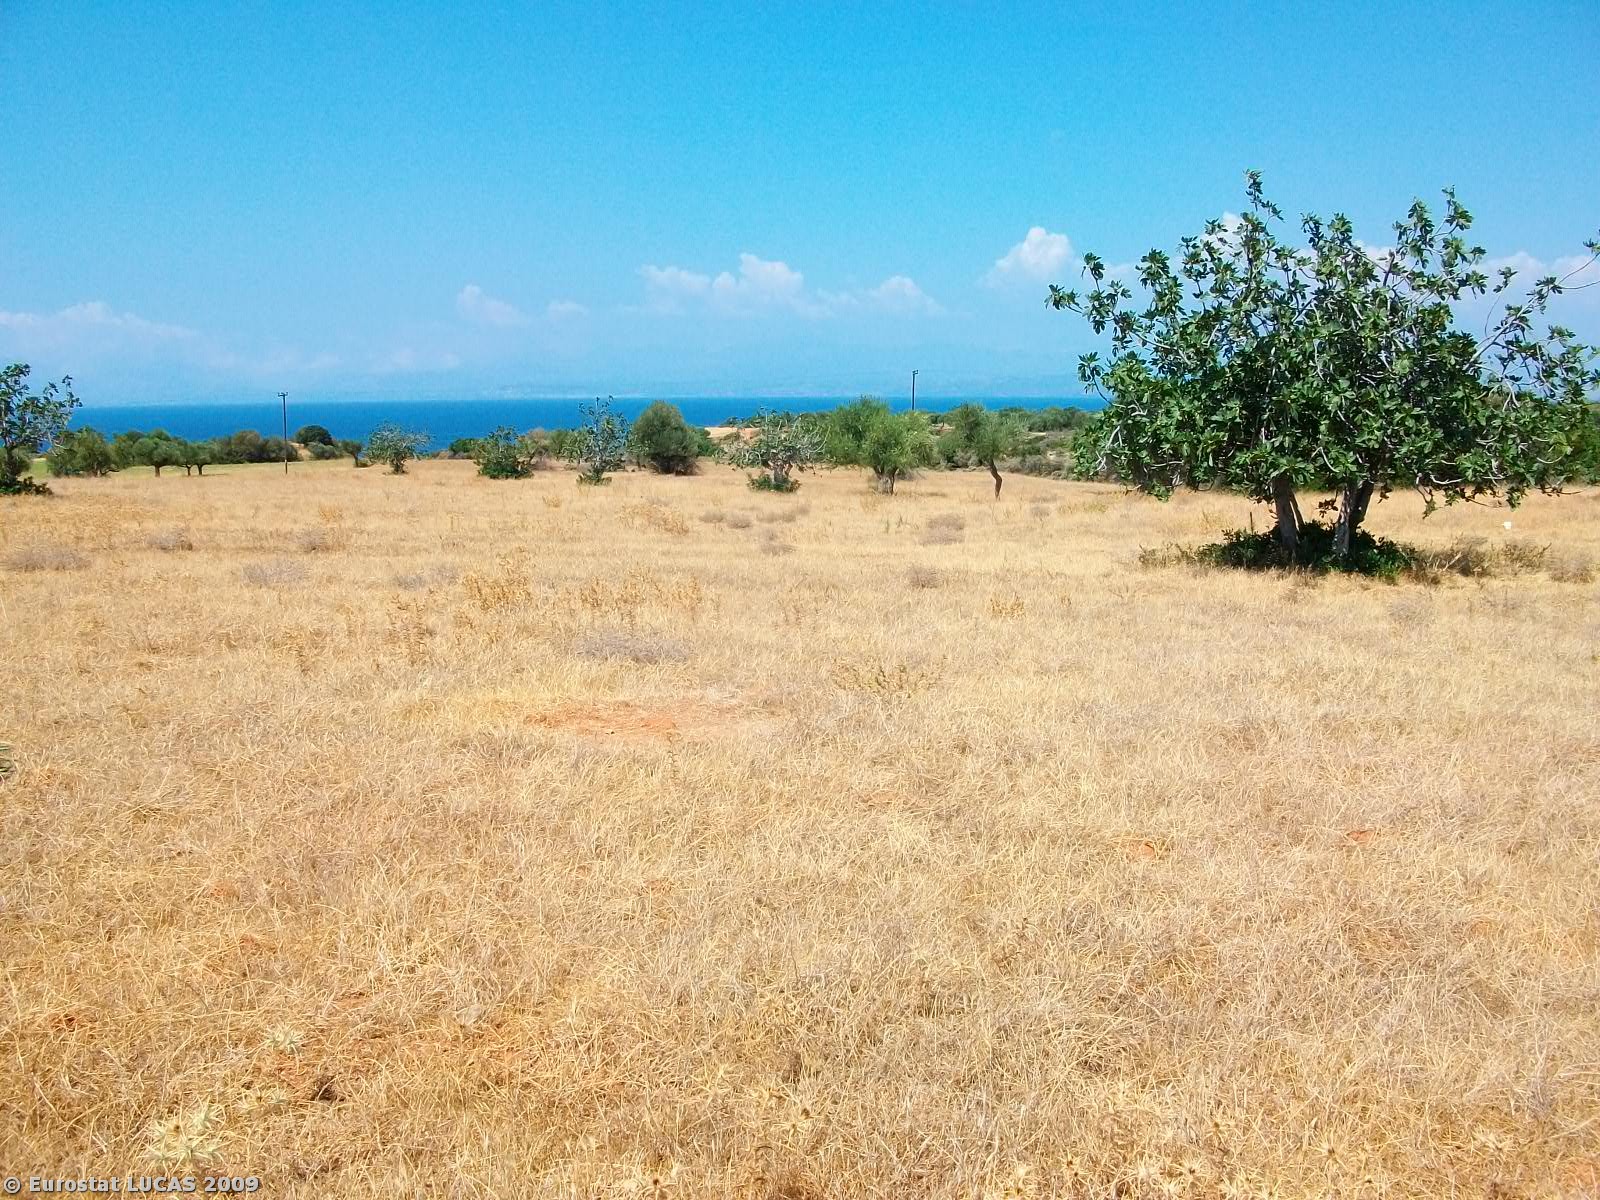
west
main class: Grassland
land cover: Grassland with sparse tree/shrub cover
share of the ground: > 75 %
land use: Agriculture (excluding fallow land and kitchen gardens)
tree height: < 5 m
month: August
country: GR
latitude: 36.7681
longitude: 22.8038
